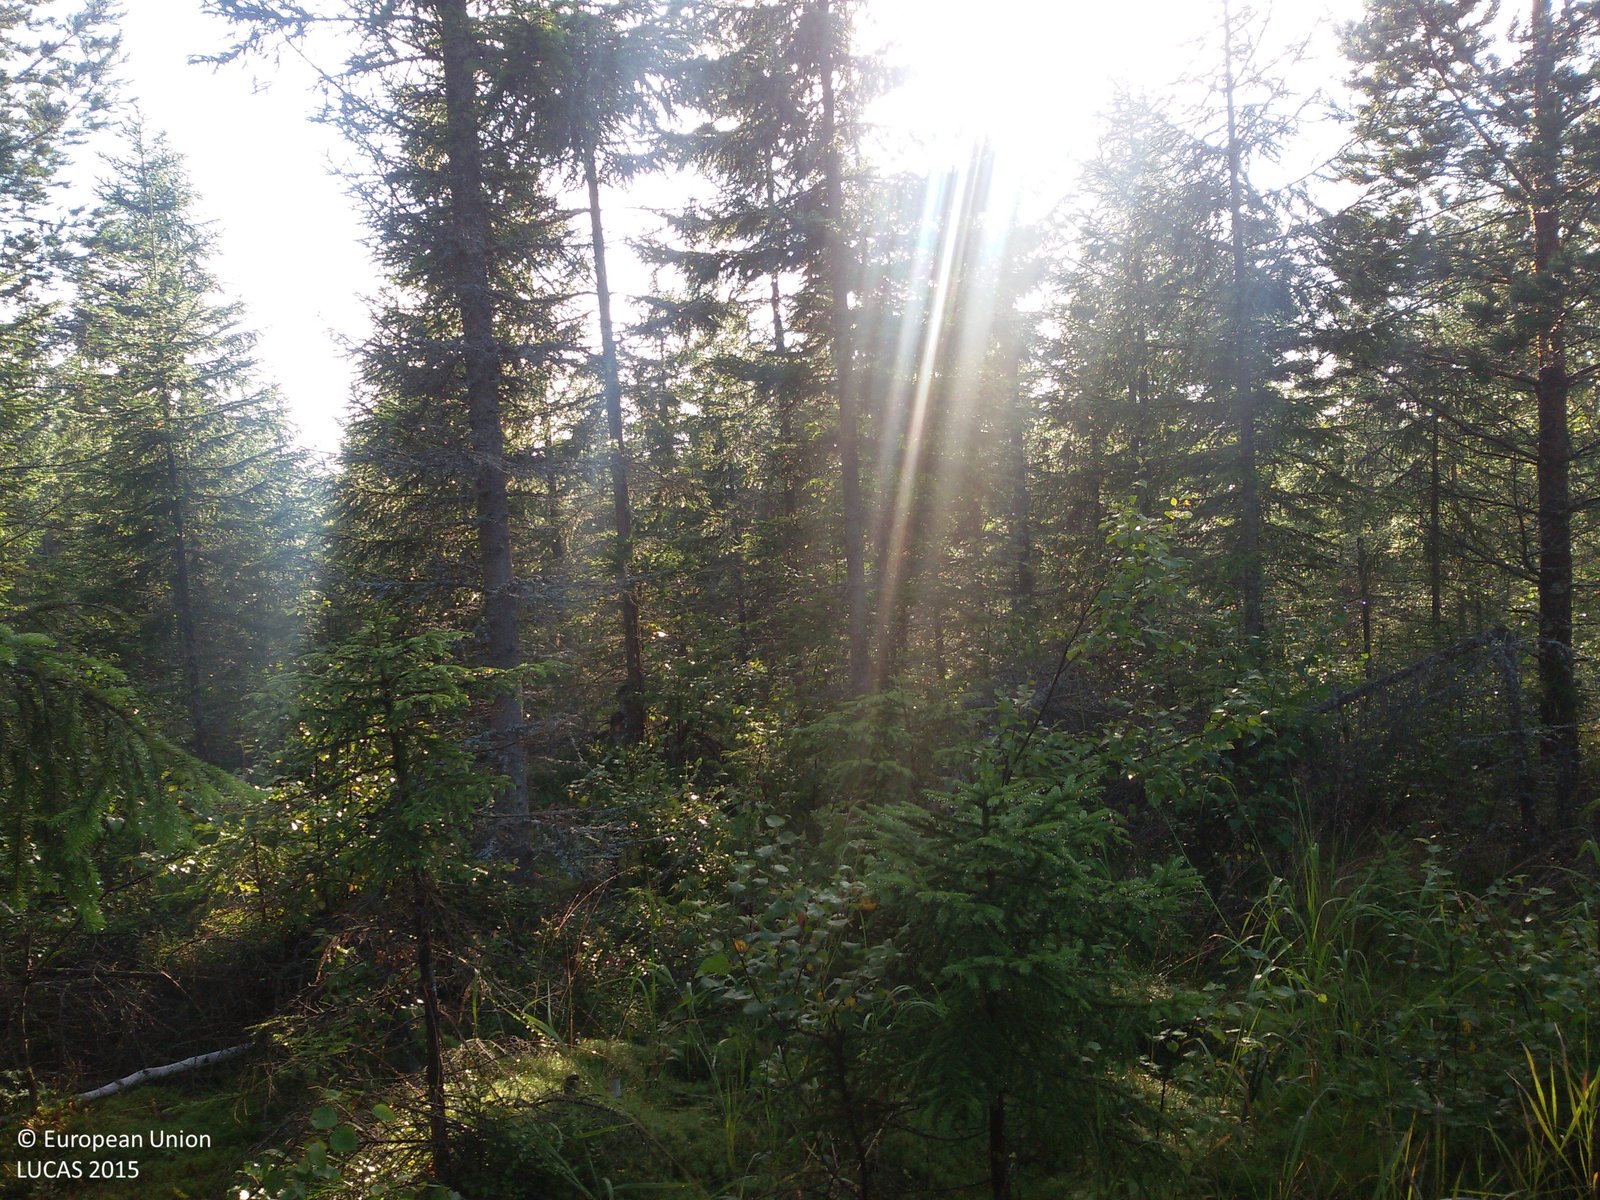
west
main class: Woodland
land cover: Spruce dominated coniferous woodland
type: boreal forest
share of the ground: 50 - 75 %
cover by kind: coniferous forest trees 50 %, herbaceous plants 30 %, broadleaved forest trees 10 %, lichens and mosses 10 %
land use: Forestry
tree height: < 5 m
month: August
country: SE
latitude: 60.8024
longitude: 16.6215
